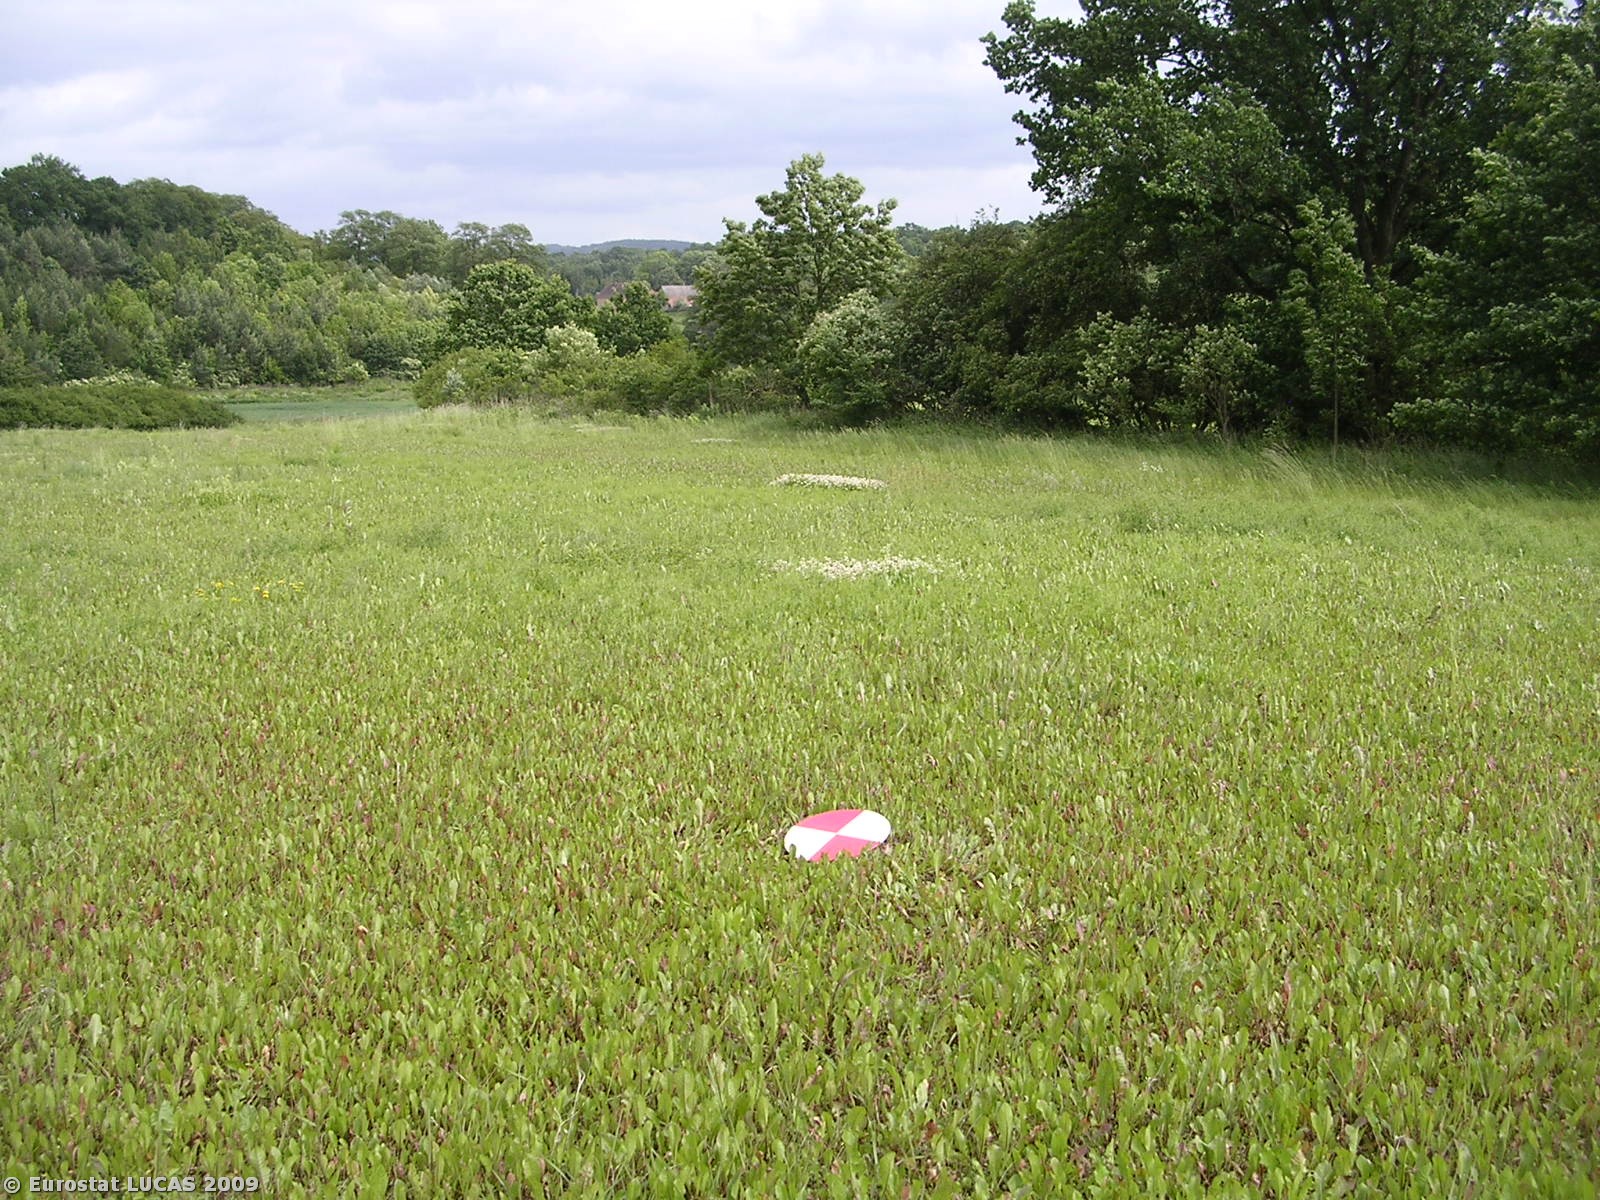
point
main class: Grassland
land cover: Grassland without tree/shrub cover
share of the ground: > 75 %
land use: Agriculture (excluding fallow land and kitchen gardens)
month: June
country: CZ
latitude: 50.5298
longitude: 14.4455
